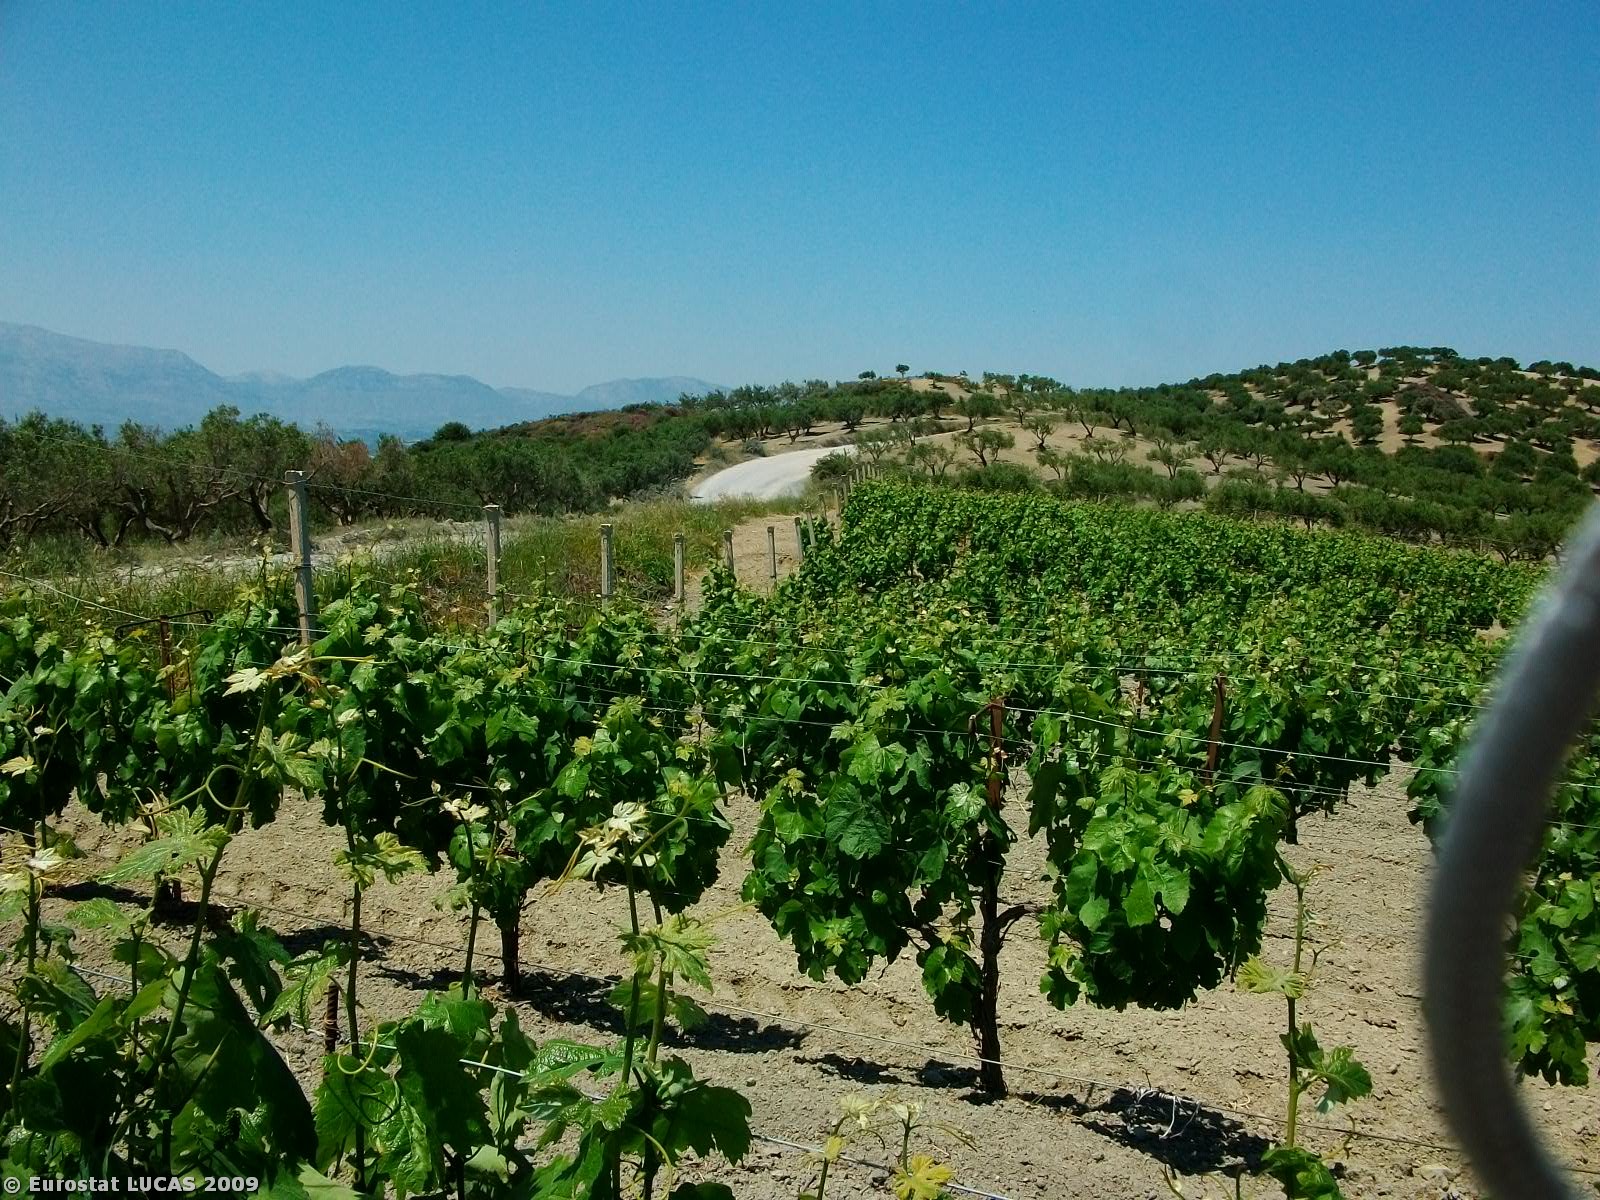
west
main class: Cropland
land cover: Vineyards
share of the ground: 25 - 50 %
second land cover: Bare land
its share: > 75 %
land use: Agriculture (excluding fallow land and kitchen gardens)
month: May
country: GR
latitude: 35.1834
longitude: 25.1334
